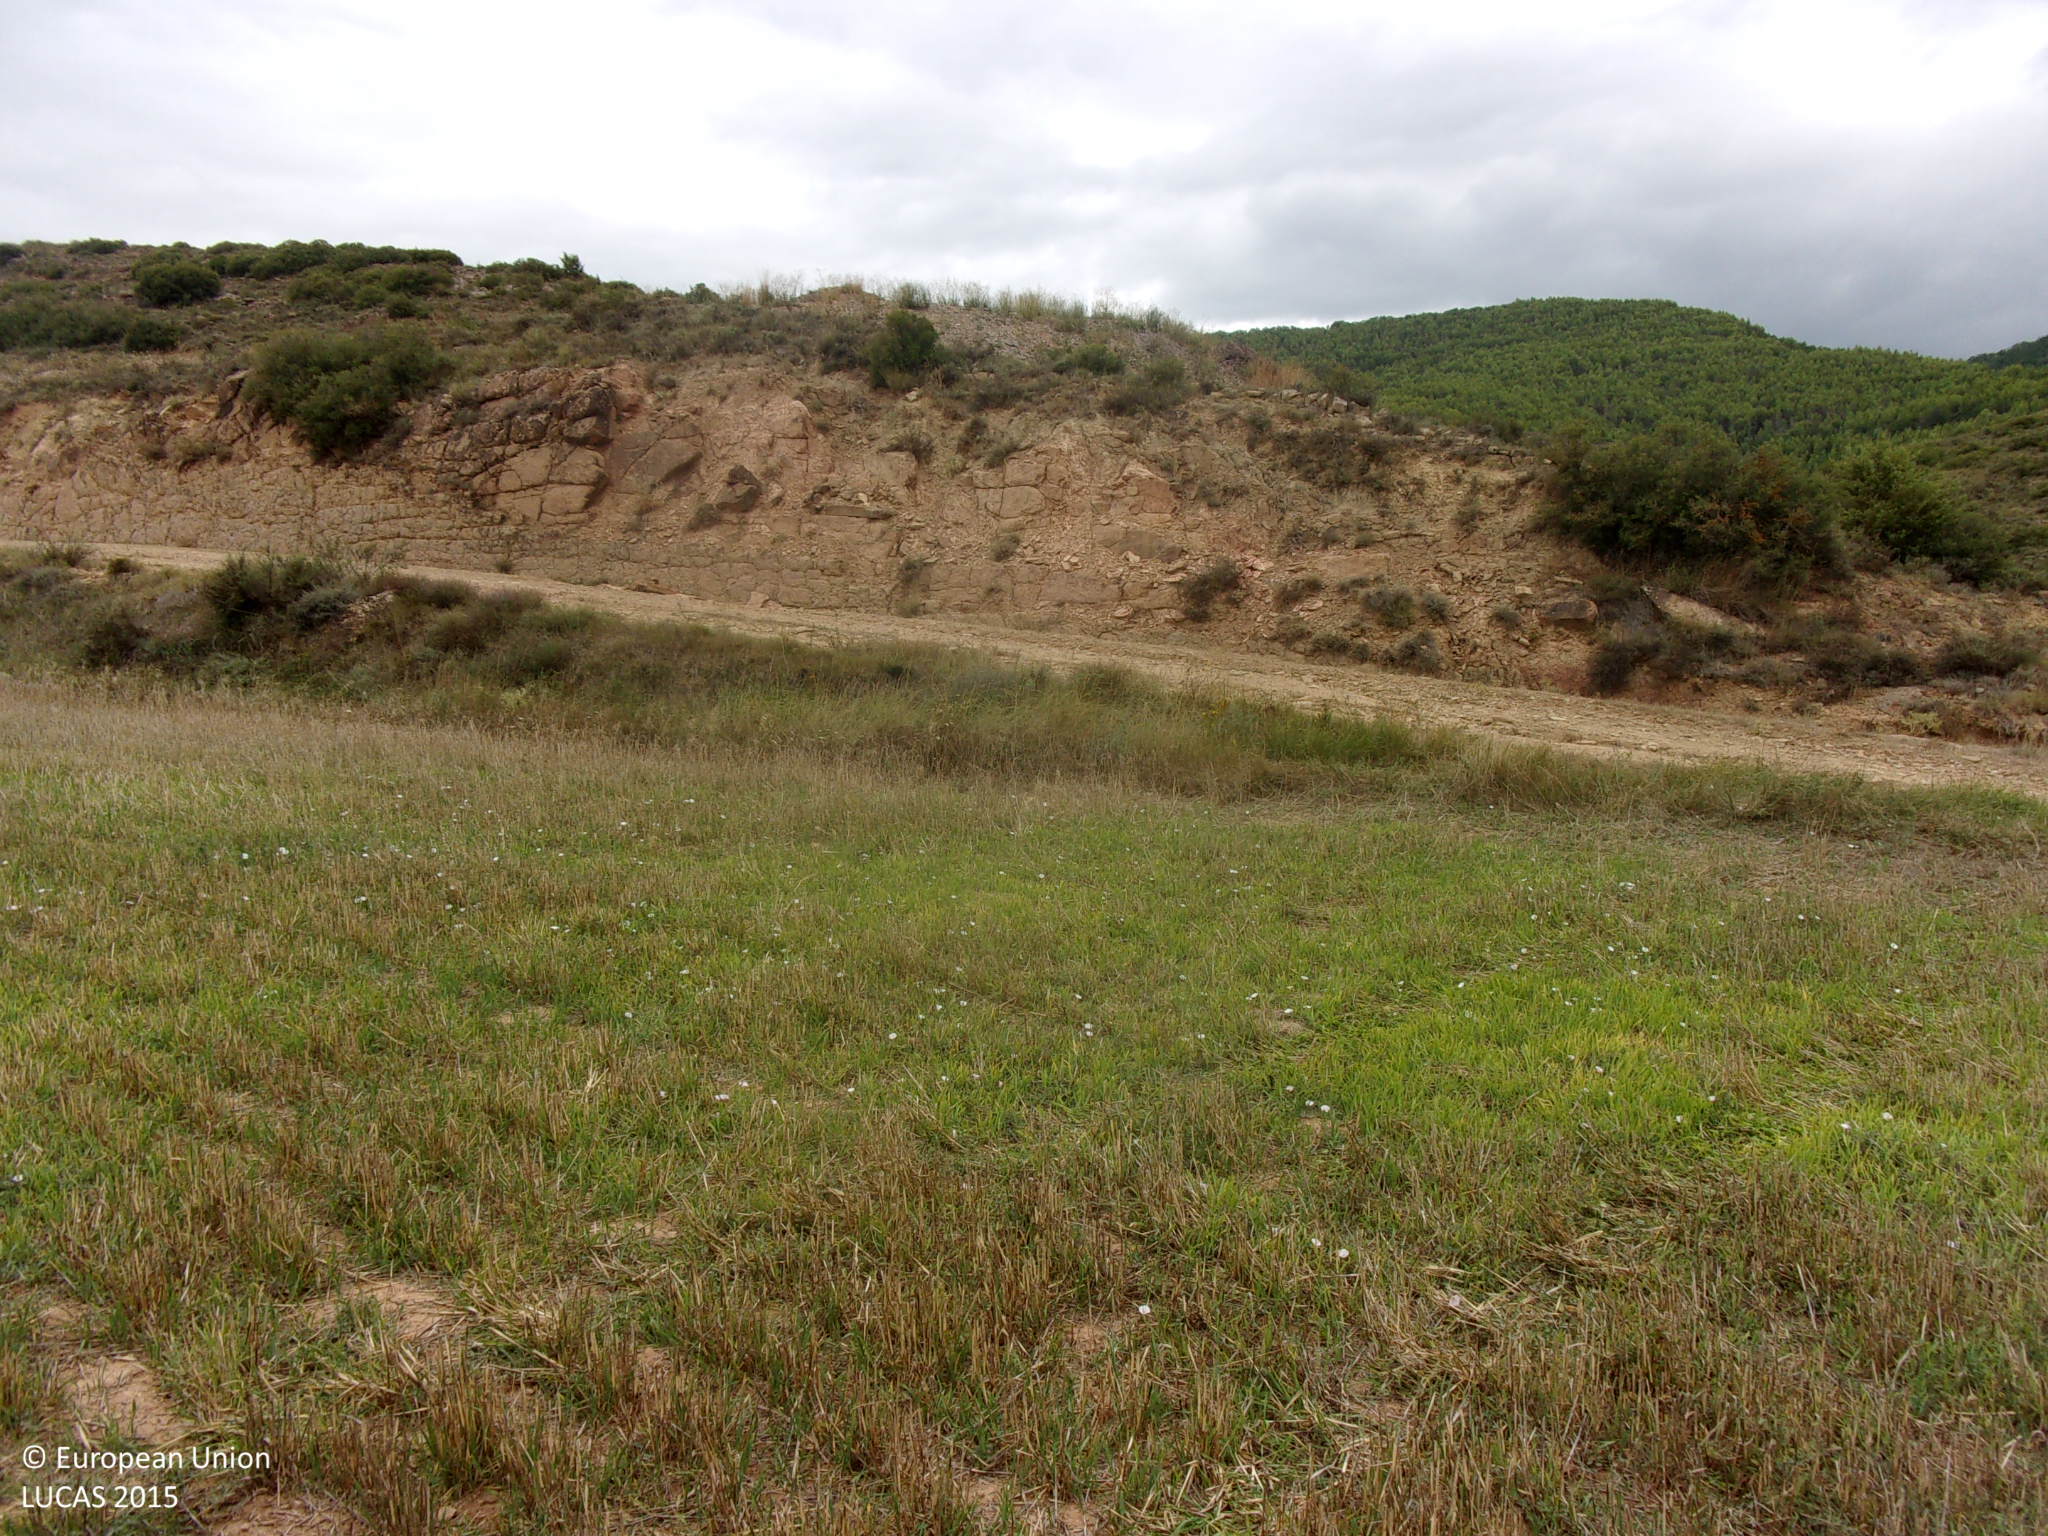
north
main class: Cropland
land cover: Barley
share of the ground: < 10 %
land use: Agriculture (excluding fallow land and kitchen gardens)
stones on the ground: < 10 %
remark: Harvested field
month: August
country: ES
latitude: 42.5312
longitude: -1.1226
